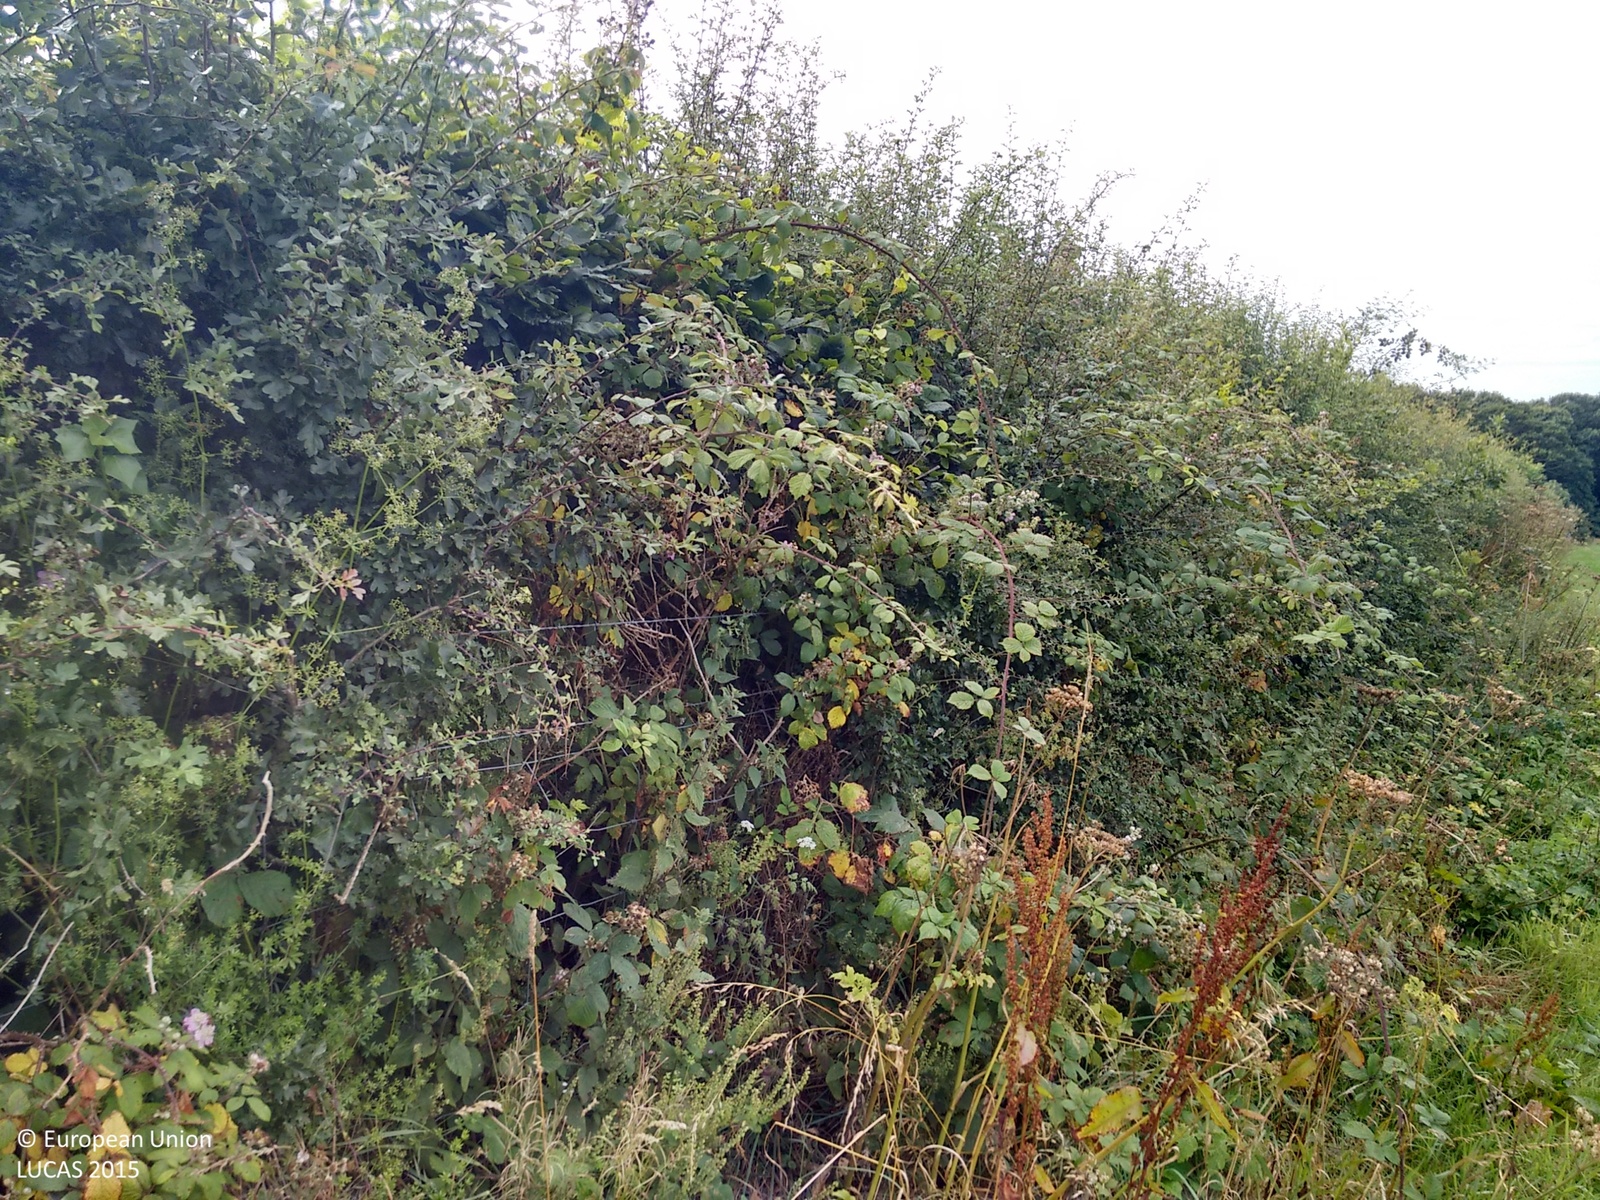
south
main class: Cropland
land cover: Sugar beet
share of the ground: > 75 %
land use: Agriculture (excluding fallow land and kitchen gardens)
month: August
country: GB
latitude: 50.4657
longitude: -4.1424
